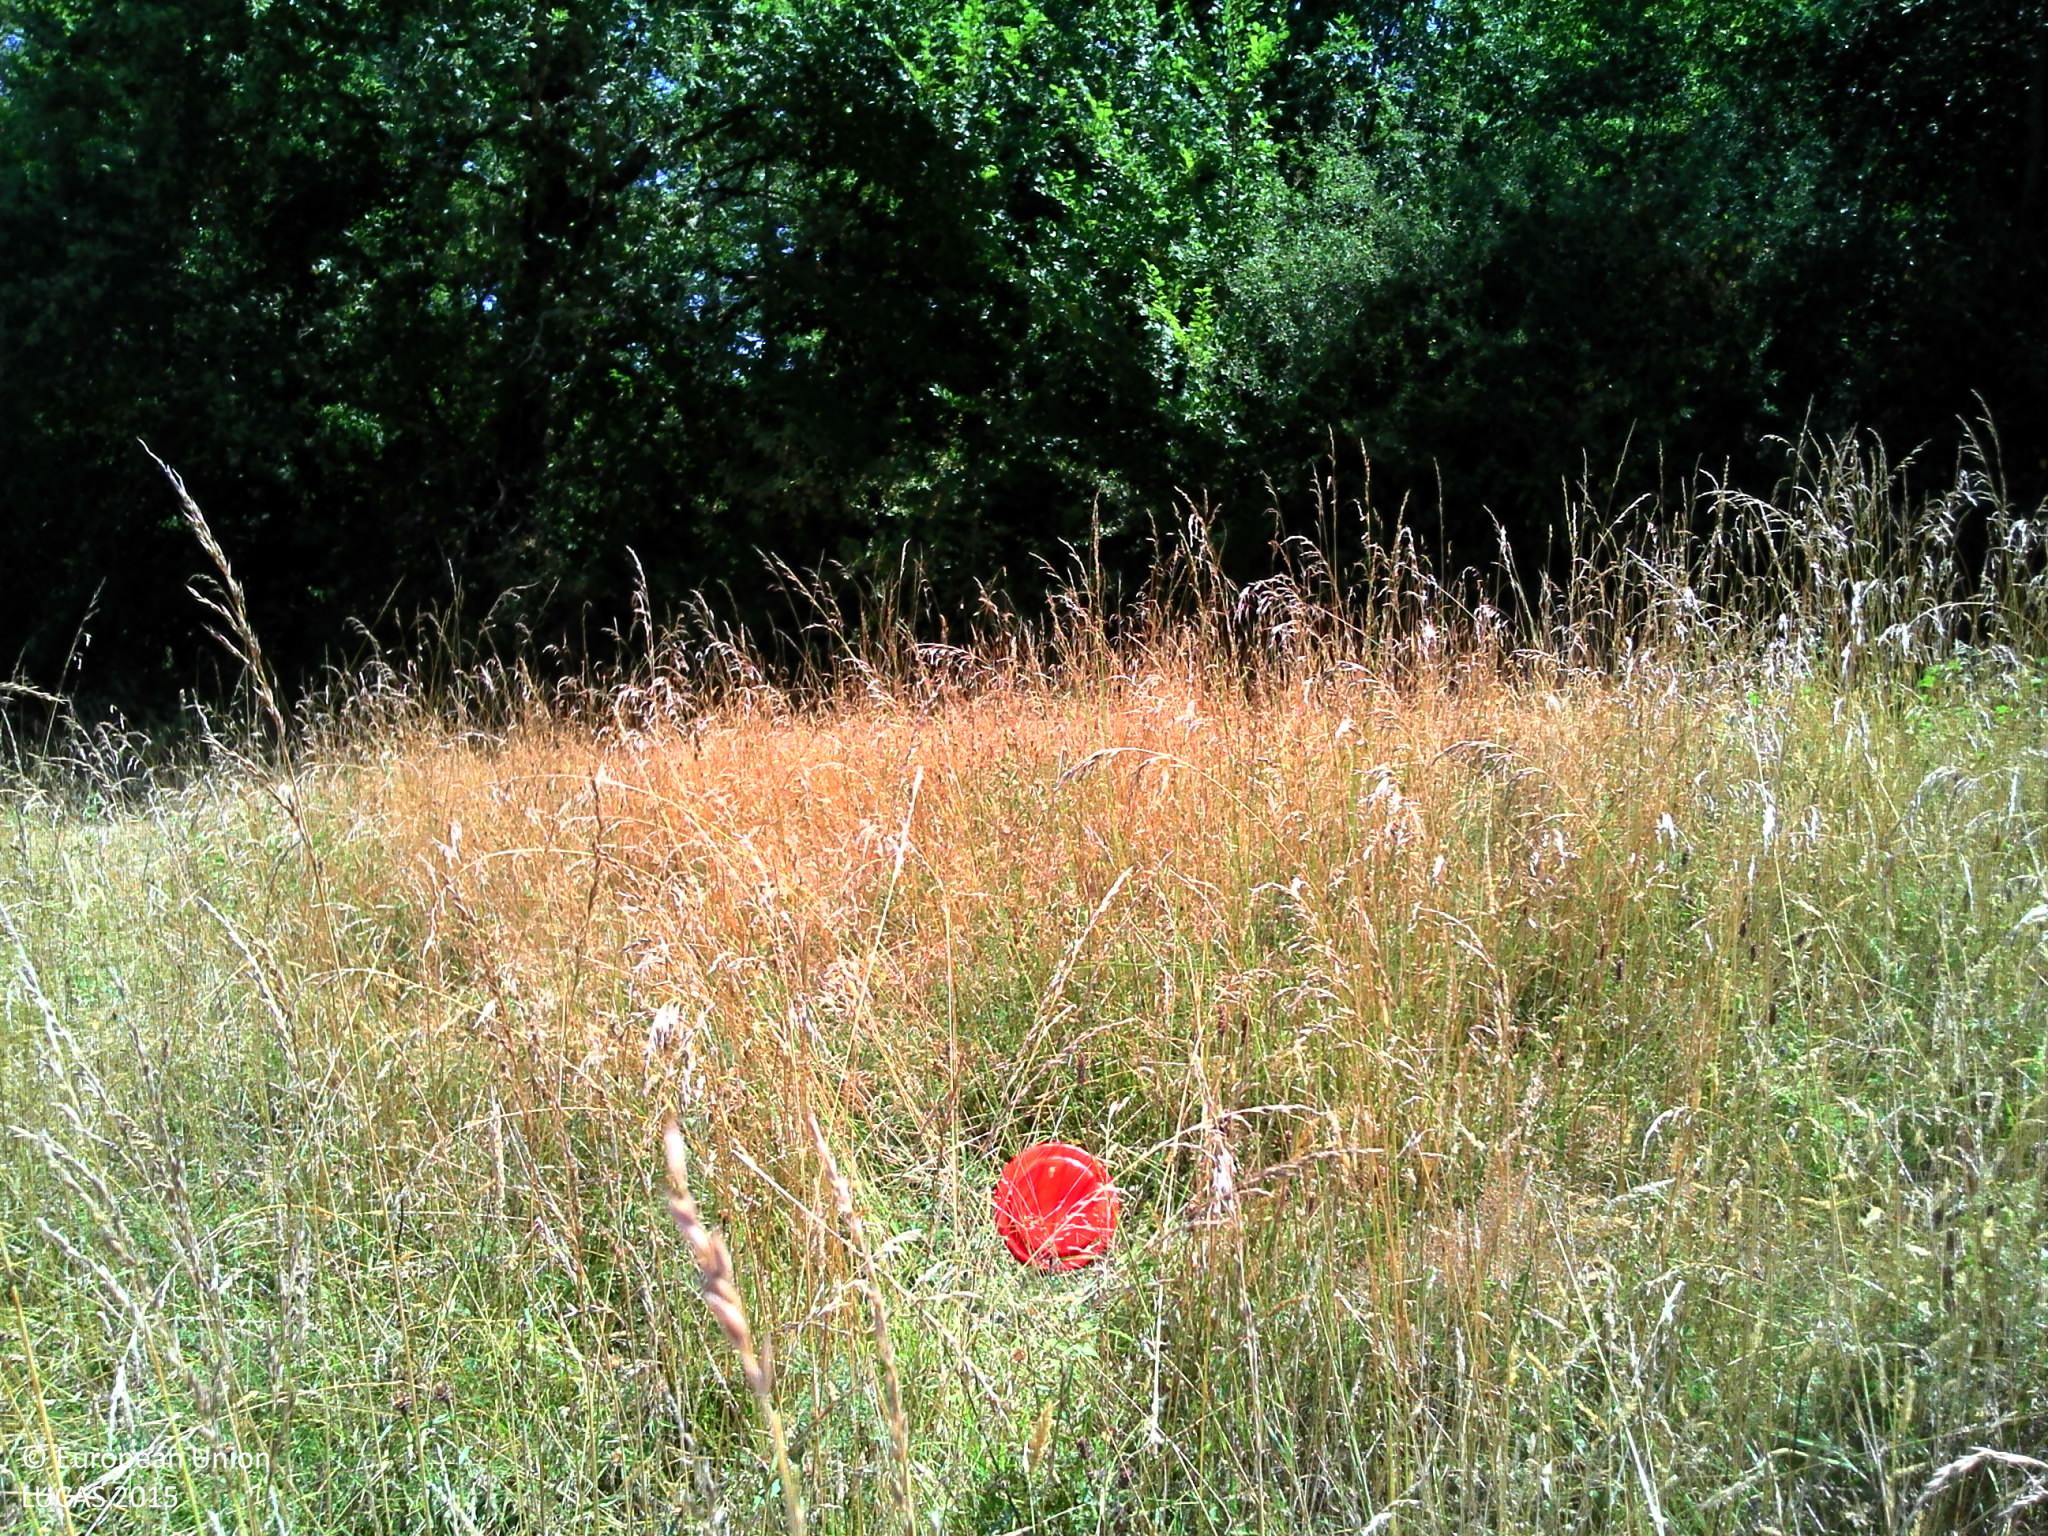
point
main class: Grassland
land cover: Grassland without tree/shrub cover
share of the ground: > 75 %
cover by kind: herbaceous plants 100 %
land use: Agriculture (excluding fallow land and kitchen gardens)
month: July
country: FR
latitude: 44.8810
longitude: 0.5591
